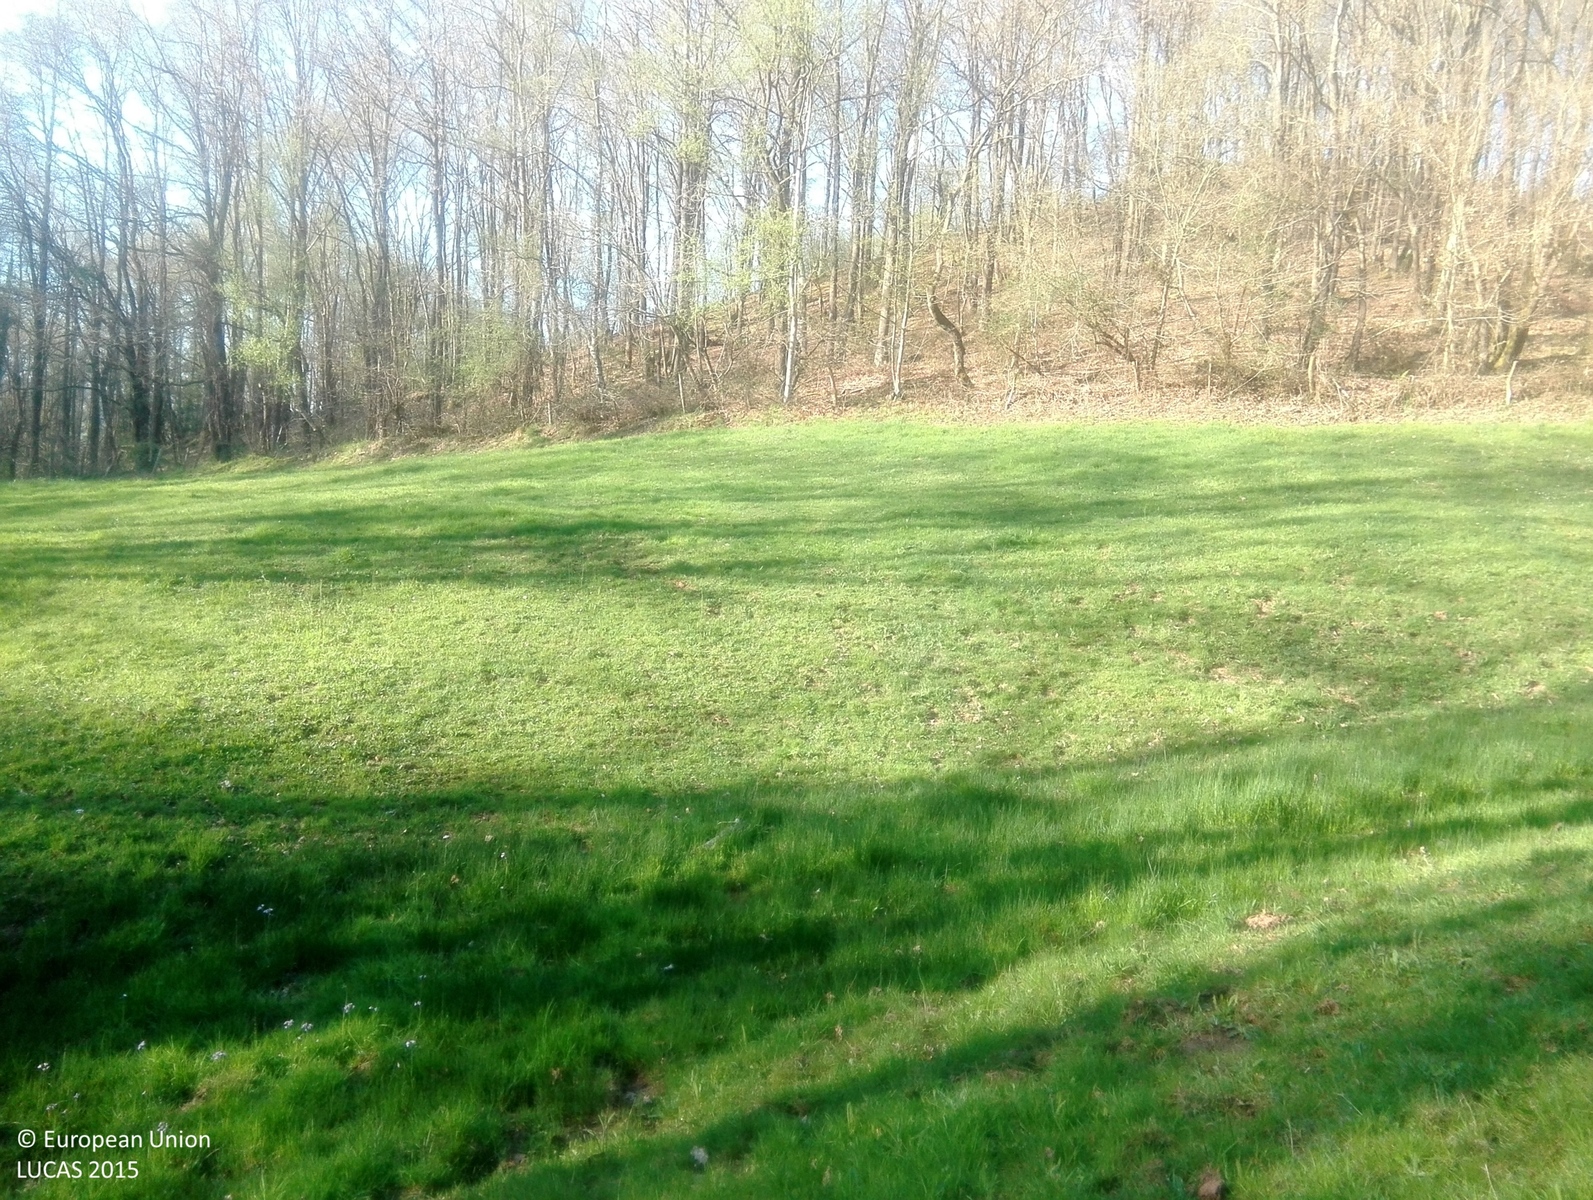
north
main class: Grassland
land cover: Grassland without tree/shrub cover
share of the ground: > 75 %
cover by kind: herbaceous plants 100 %
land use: Agriculture (excluding fallow land and kitchen gardens)
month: April
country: ES
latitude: 43.3787
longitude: -5.6225
